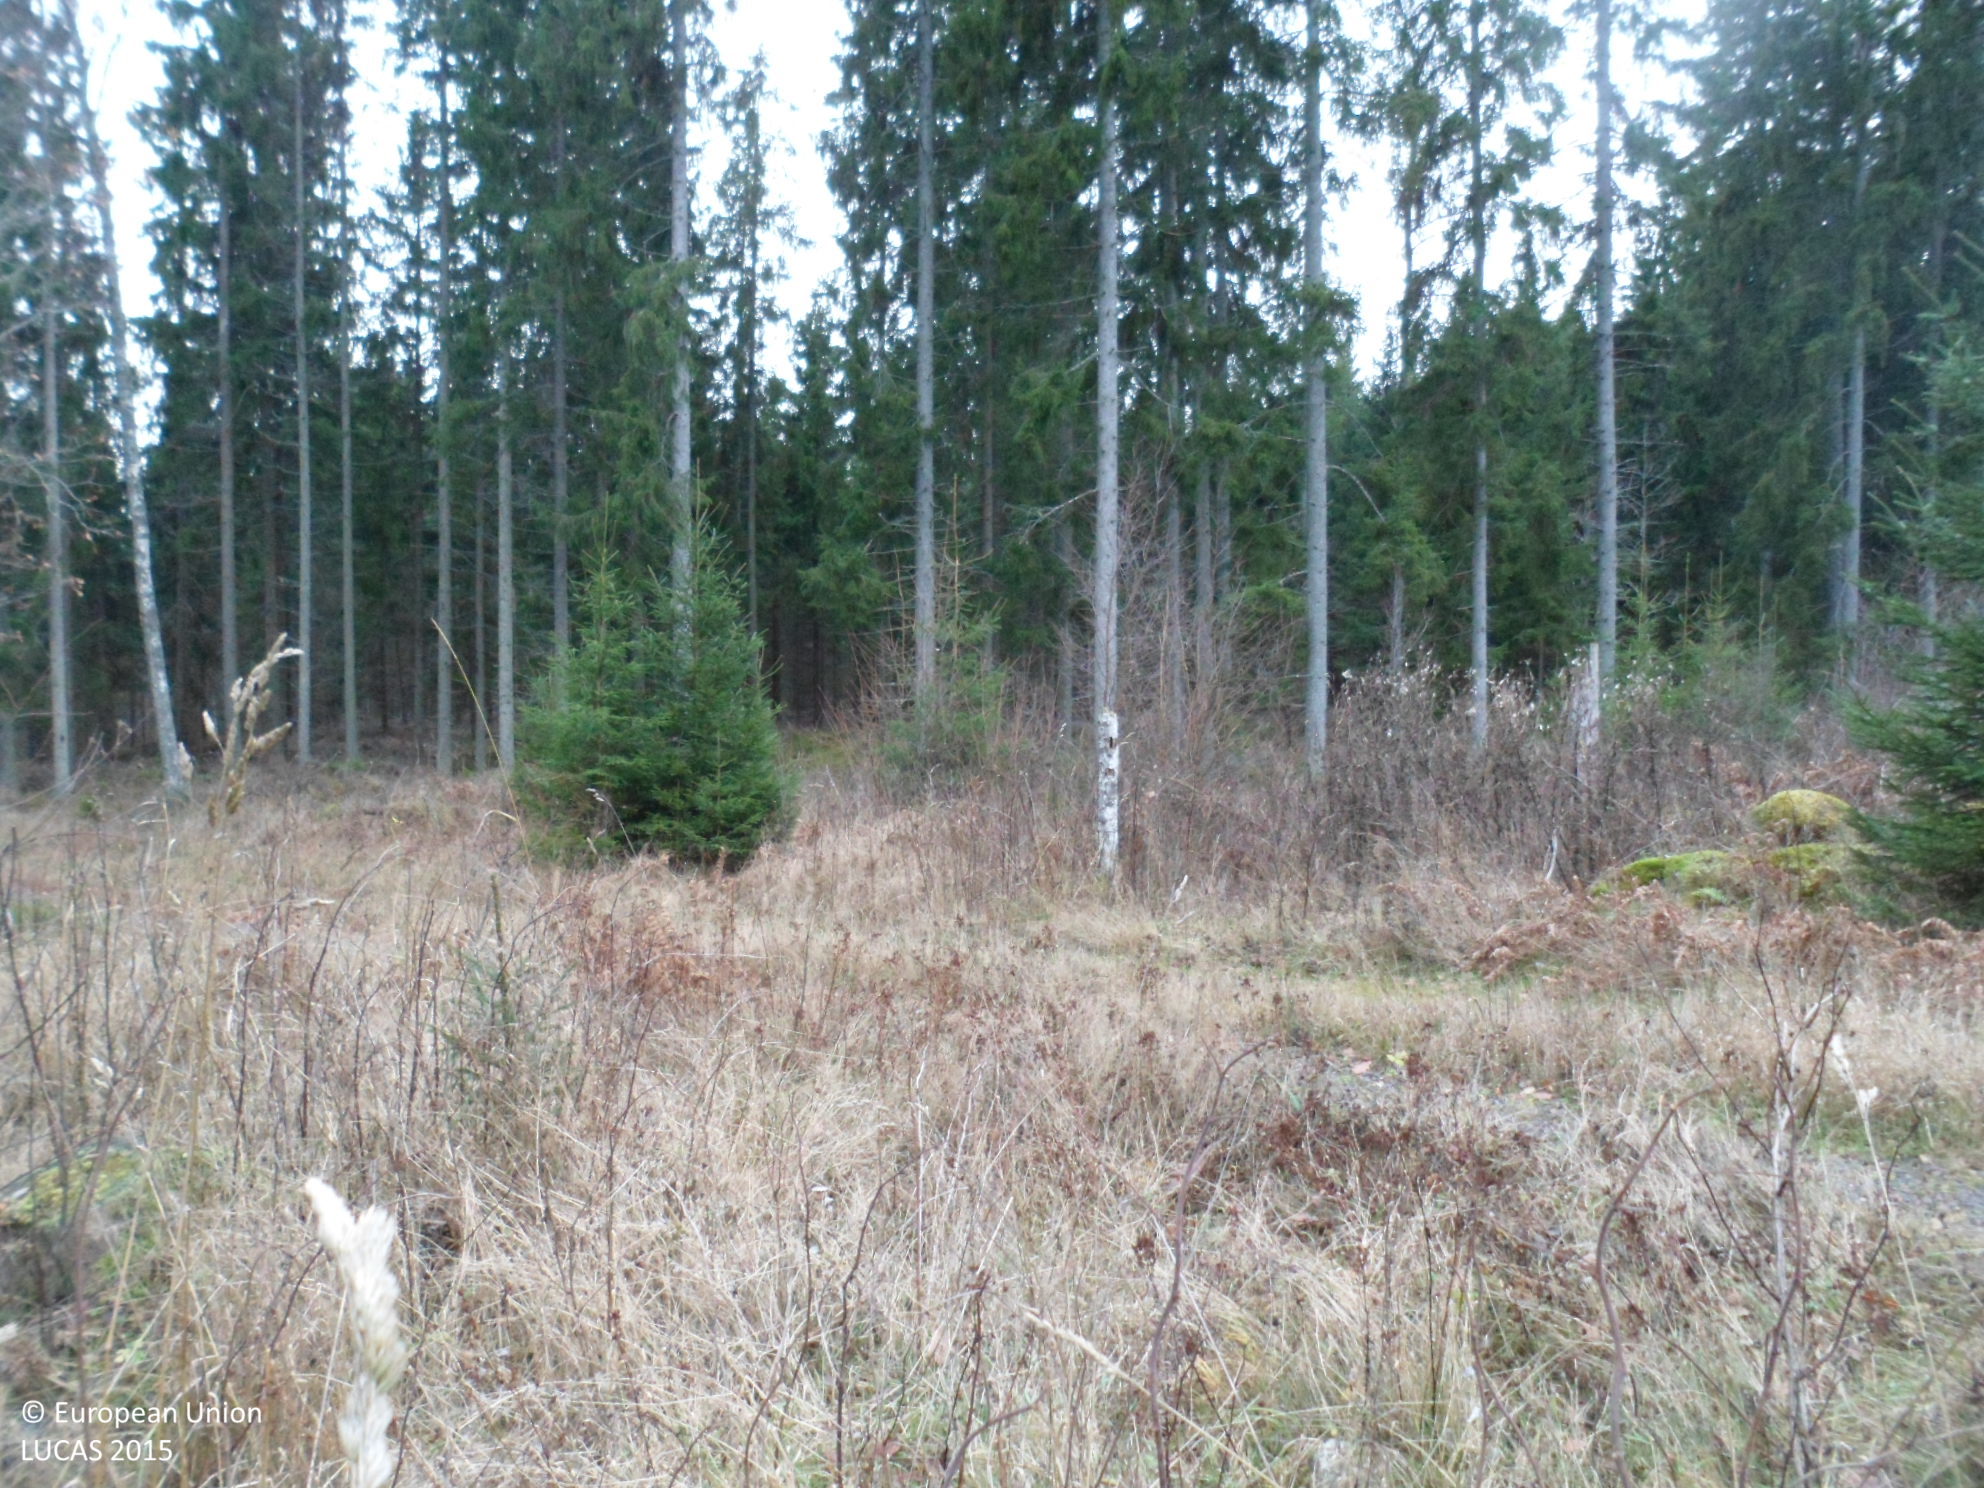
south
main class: Woodland
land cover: Spruce dominated mixed woodland
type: boreal forest
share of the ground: 25 - 50 %
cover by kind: shrubs 30 %, herbaceous plants 30 %, broadleaved forest trees 25 %, coniferous forest trees 10 %, lichens and mosses 5 %
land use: Forestry
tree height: < 5 m
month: November
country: SE
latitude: 57.1486
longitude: 15.5679
